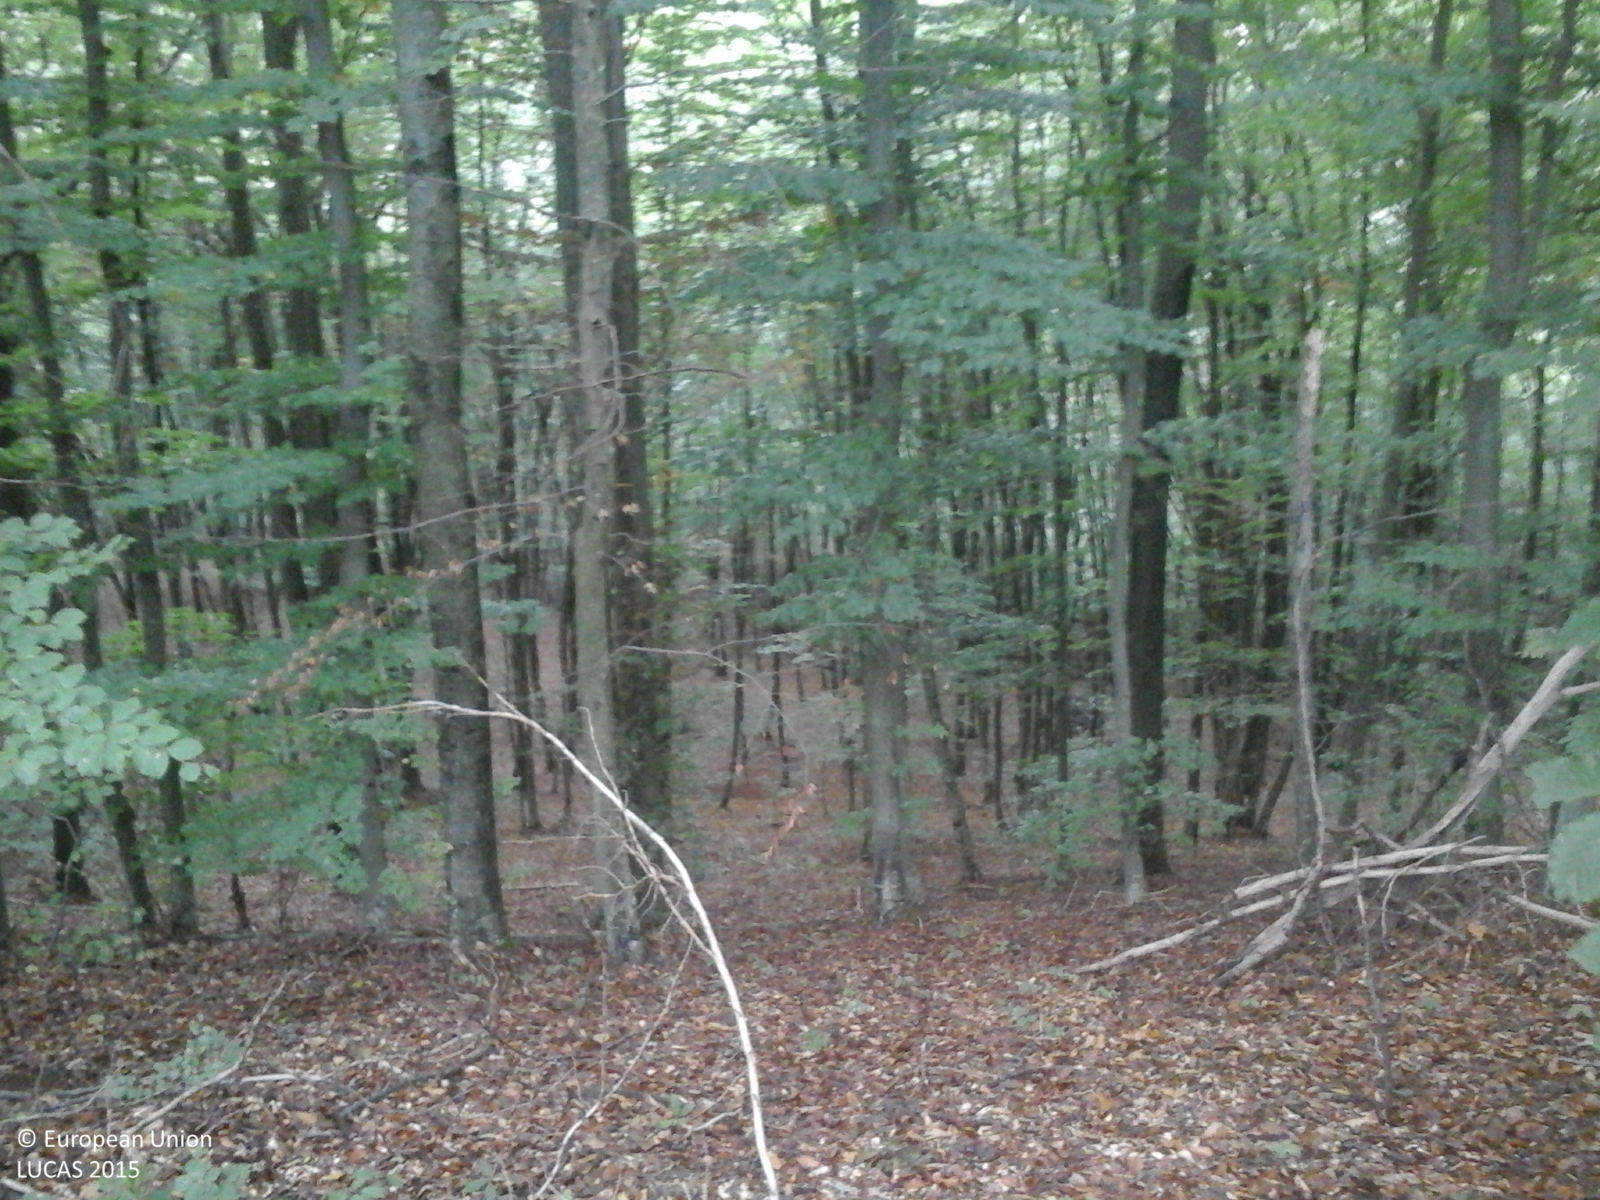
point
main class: Woodland
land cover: Broadleaved woodland
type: beech forest
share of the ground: > 75 %
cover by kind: broadleaved forest trees 100 %
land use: Forestry
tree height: > 5 m
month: September
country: RO
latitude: 45.7748
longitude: 22.2219
